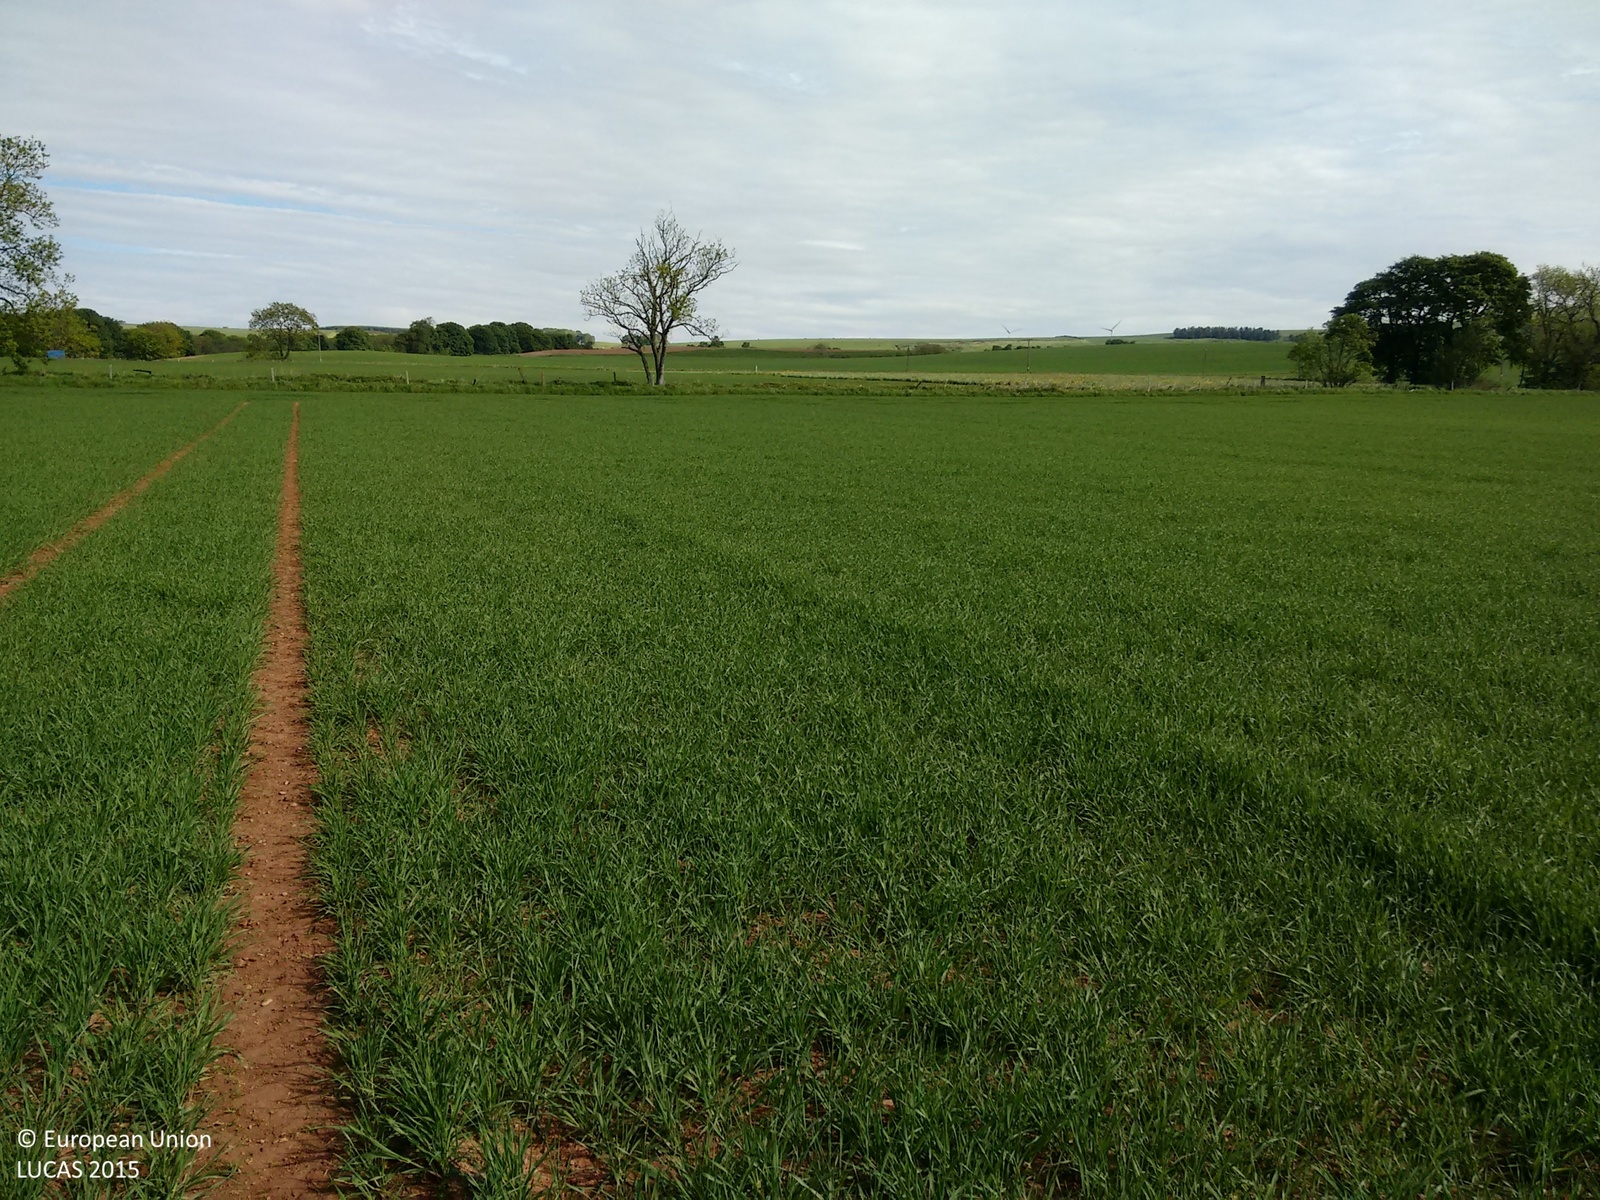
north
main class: Cropland
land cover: Barley
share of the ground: 25 - 50 %
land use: Agriculture (excluding fallow land and kitchen gardens)
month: June
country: GB
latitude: 56.8937
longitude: -2.4154
